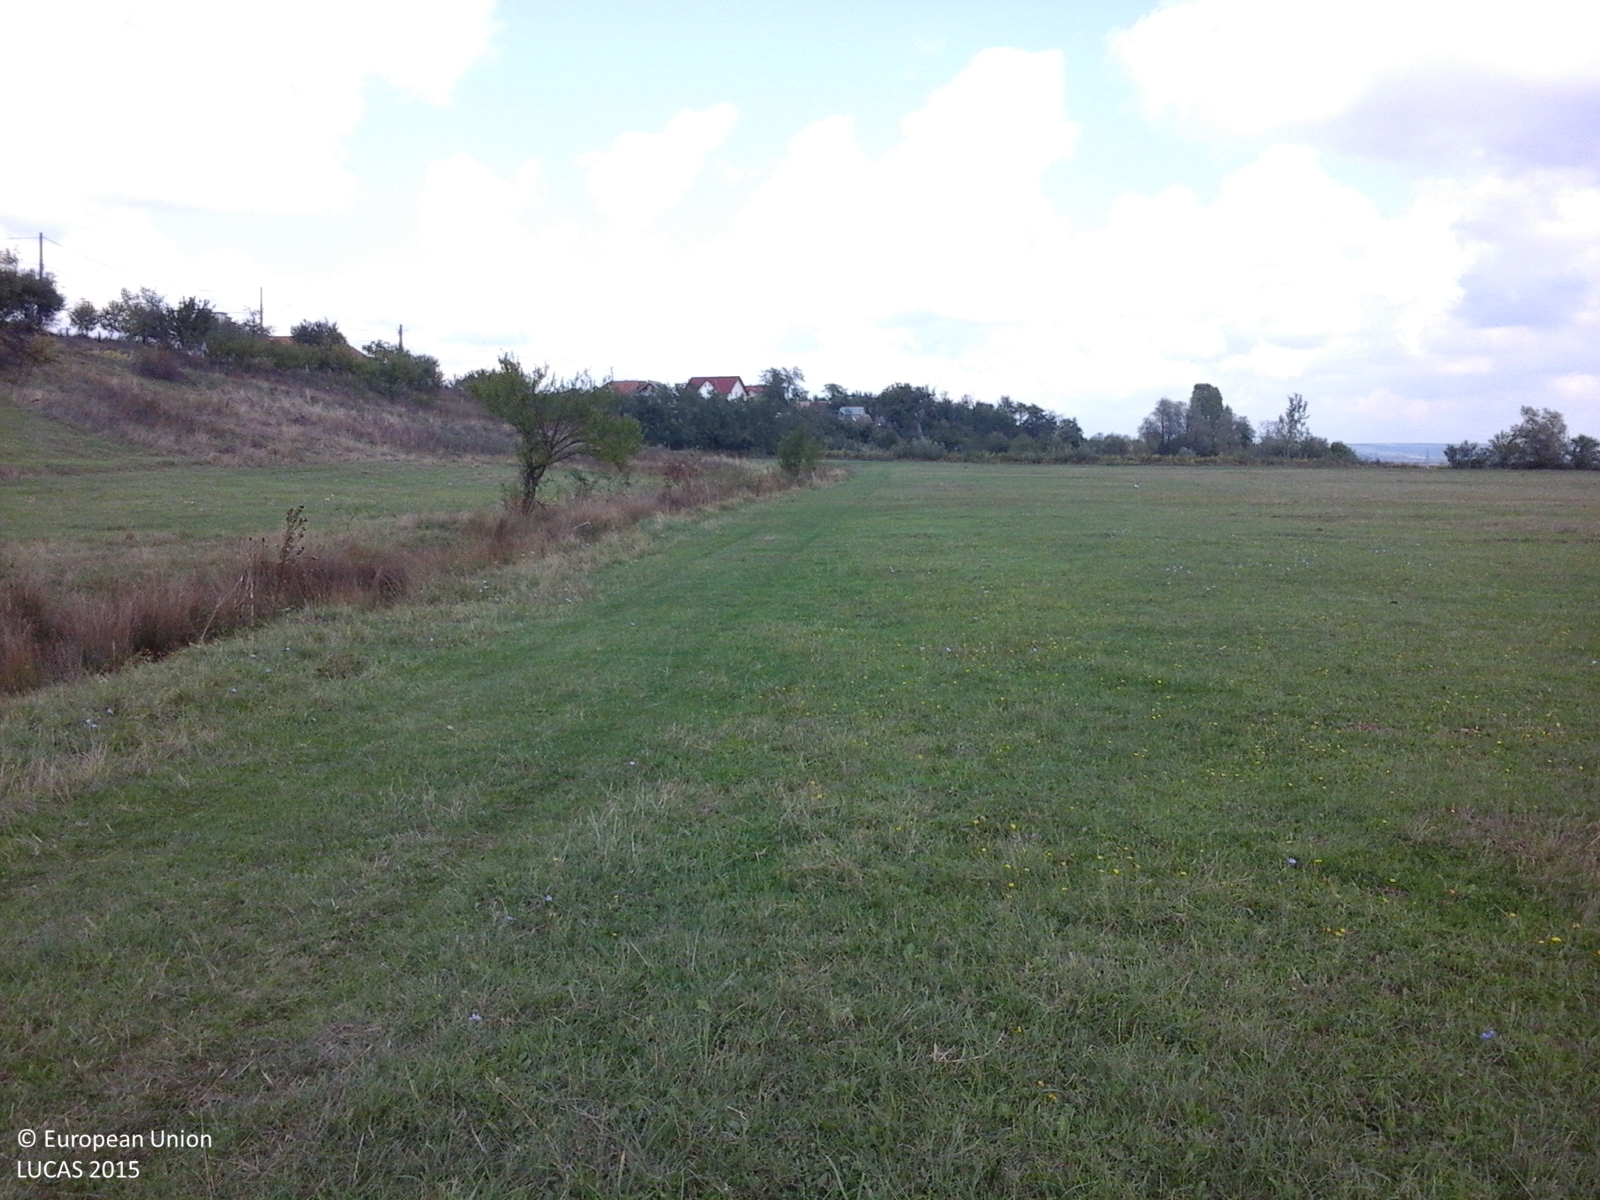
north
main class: Grassland
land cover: Grassland without tree/shrub cover
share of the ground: > 75 %
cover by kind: herbaceous plants 100 %
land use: Agriculture (excluding fallow land and kitchen gardens)
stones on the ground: < 10 %
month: September
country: RO
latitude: 44.9924
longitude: 23.5412
